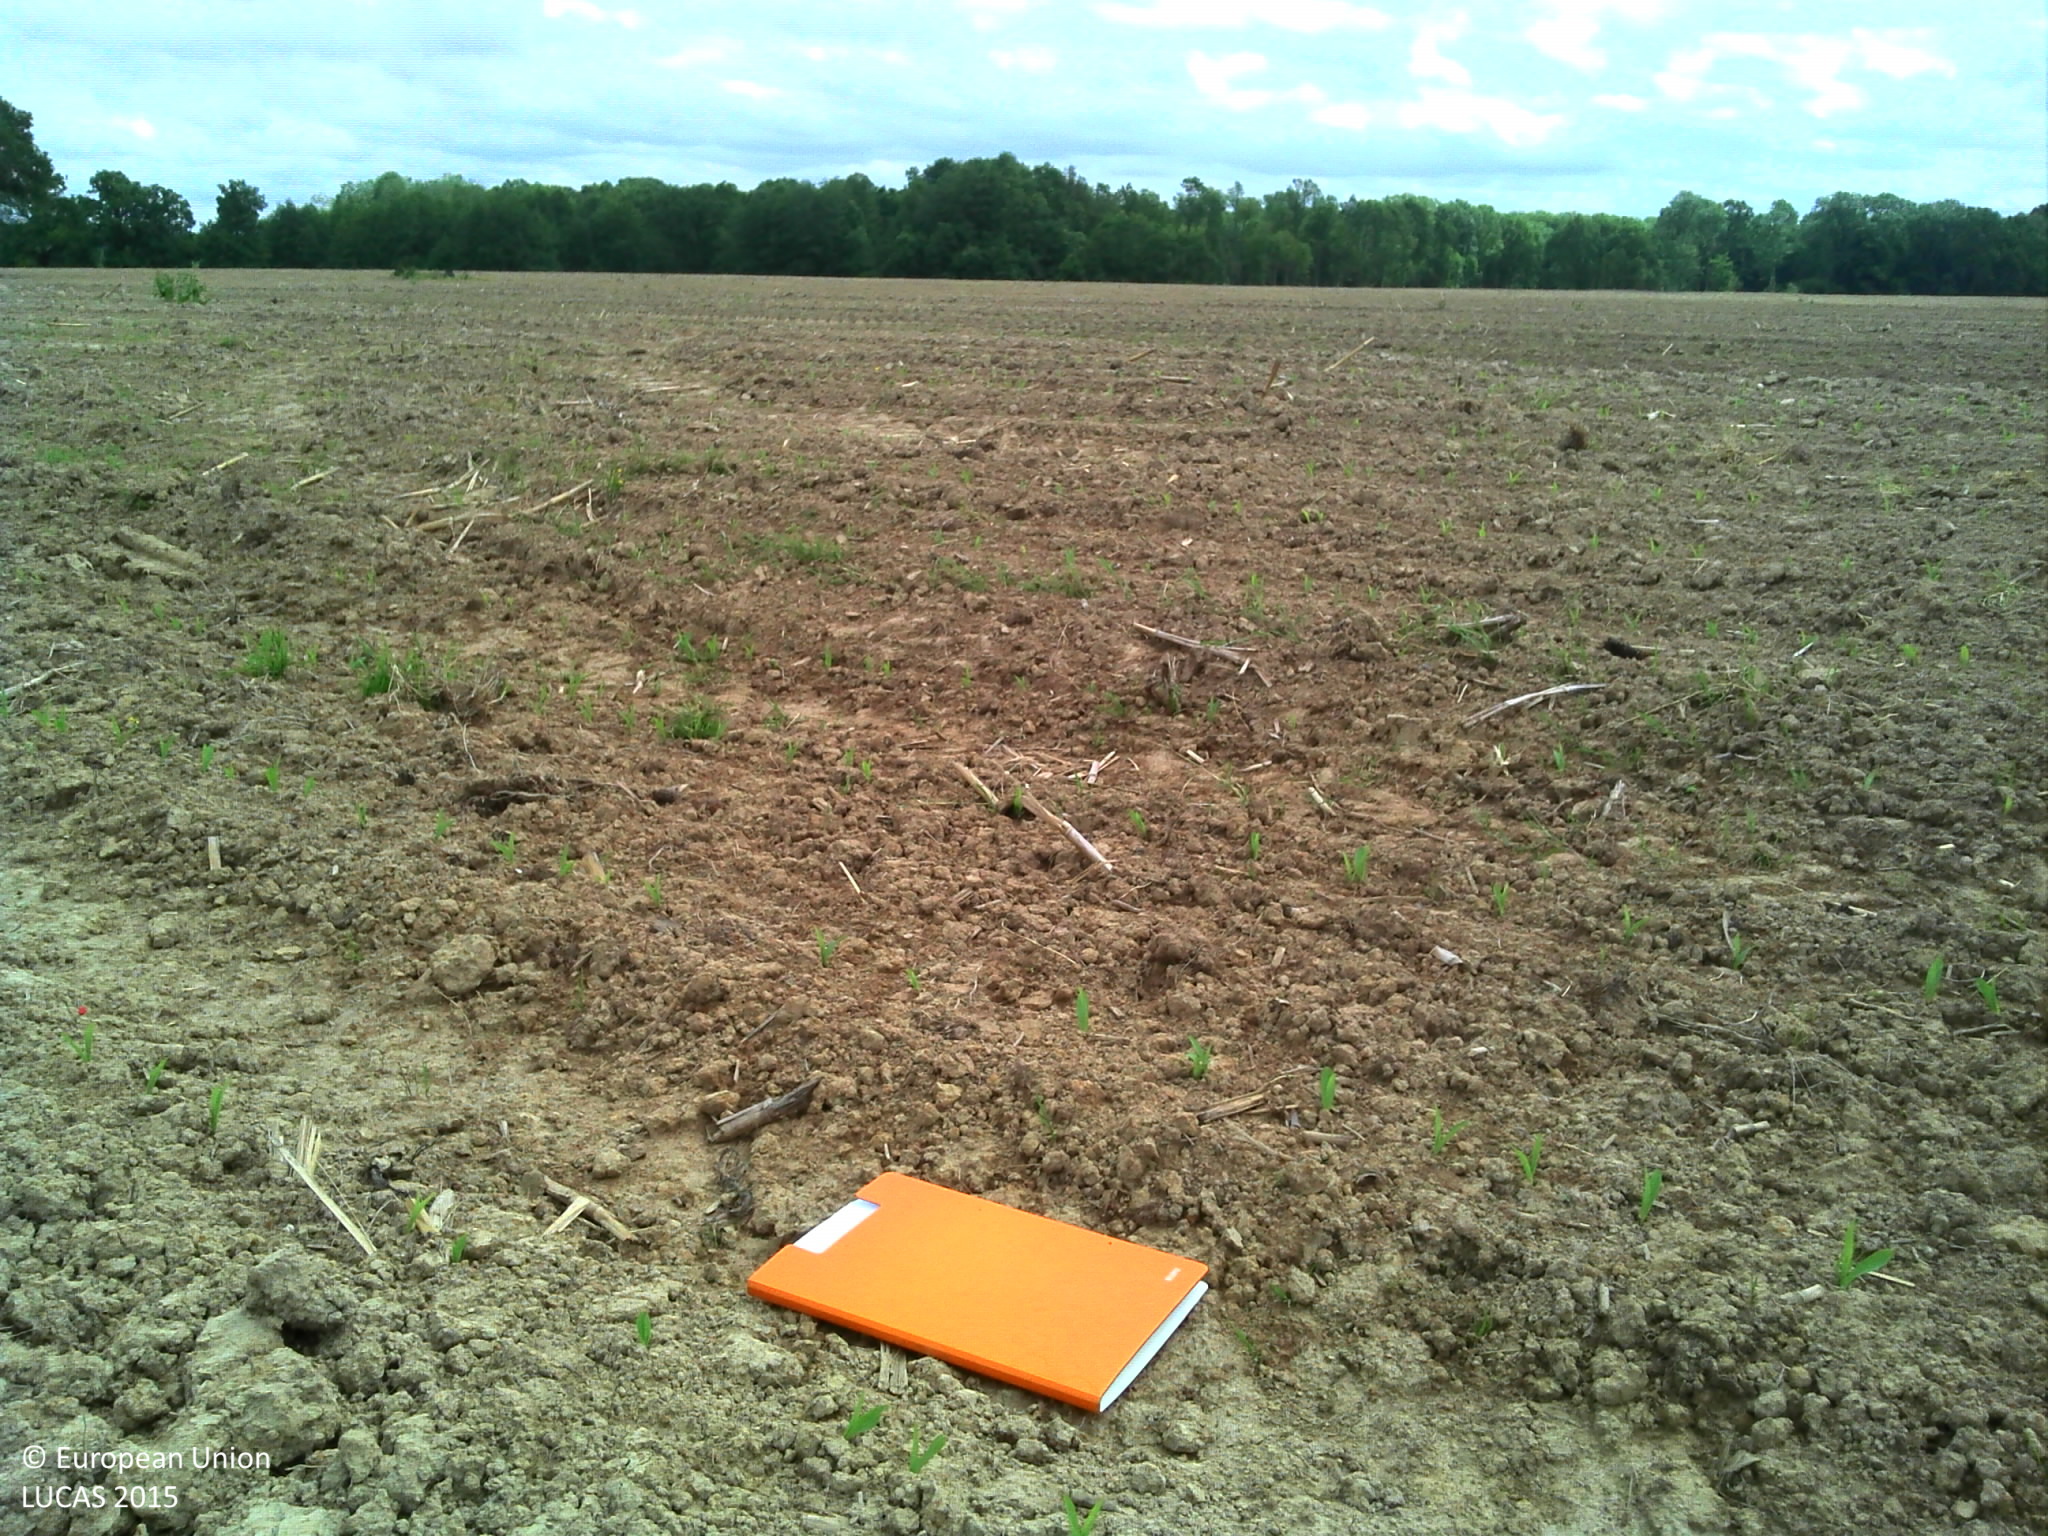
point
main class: Cropland
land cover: Maize
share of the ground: < 10 %
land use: Agriculture (excluding fallow land and kitchen gardens)
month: June
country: FR
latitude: 48.4995
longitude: 4.8418
